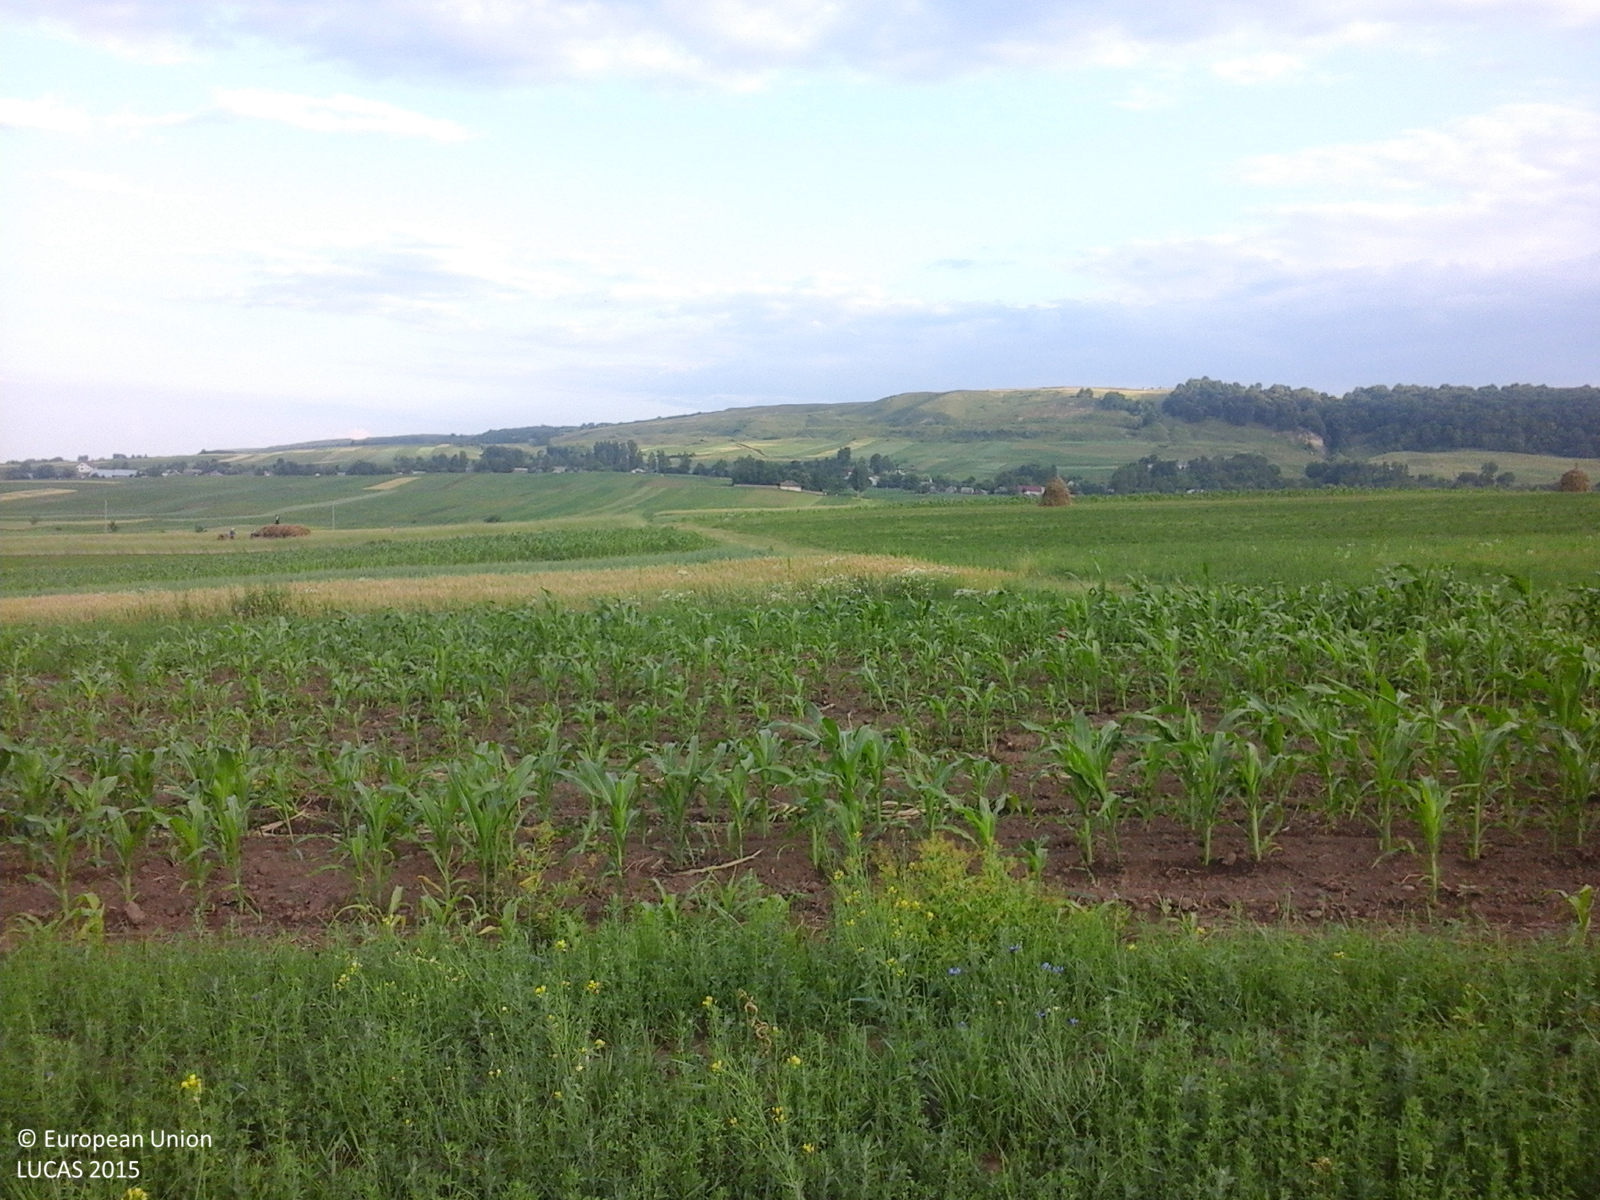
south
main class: Cropland
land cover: Other leguminous and mixtures for fodder
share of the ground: > 75 %
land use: Agriculture (excluding fallow land and kitchen gardens)
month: June
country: RO
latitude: 47.4957
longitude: 26.5365
